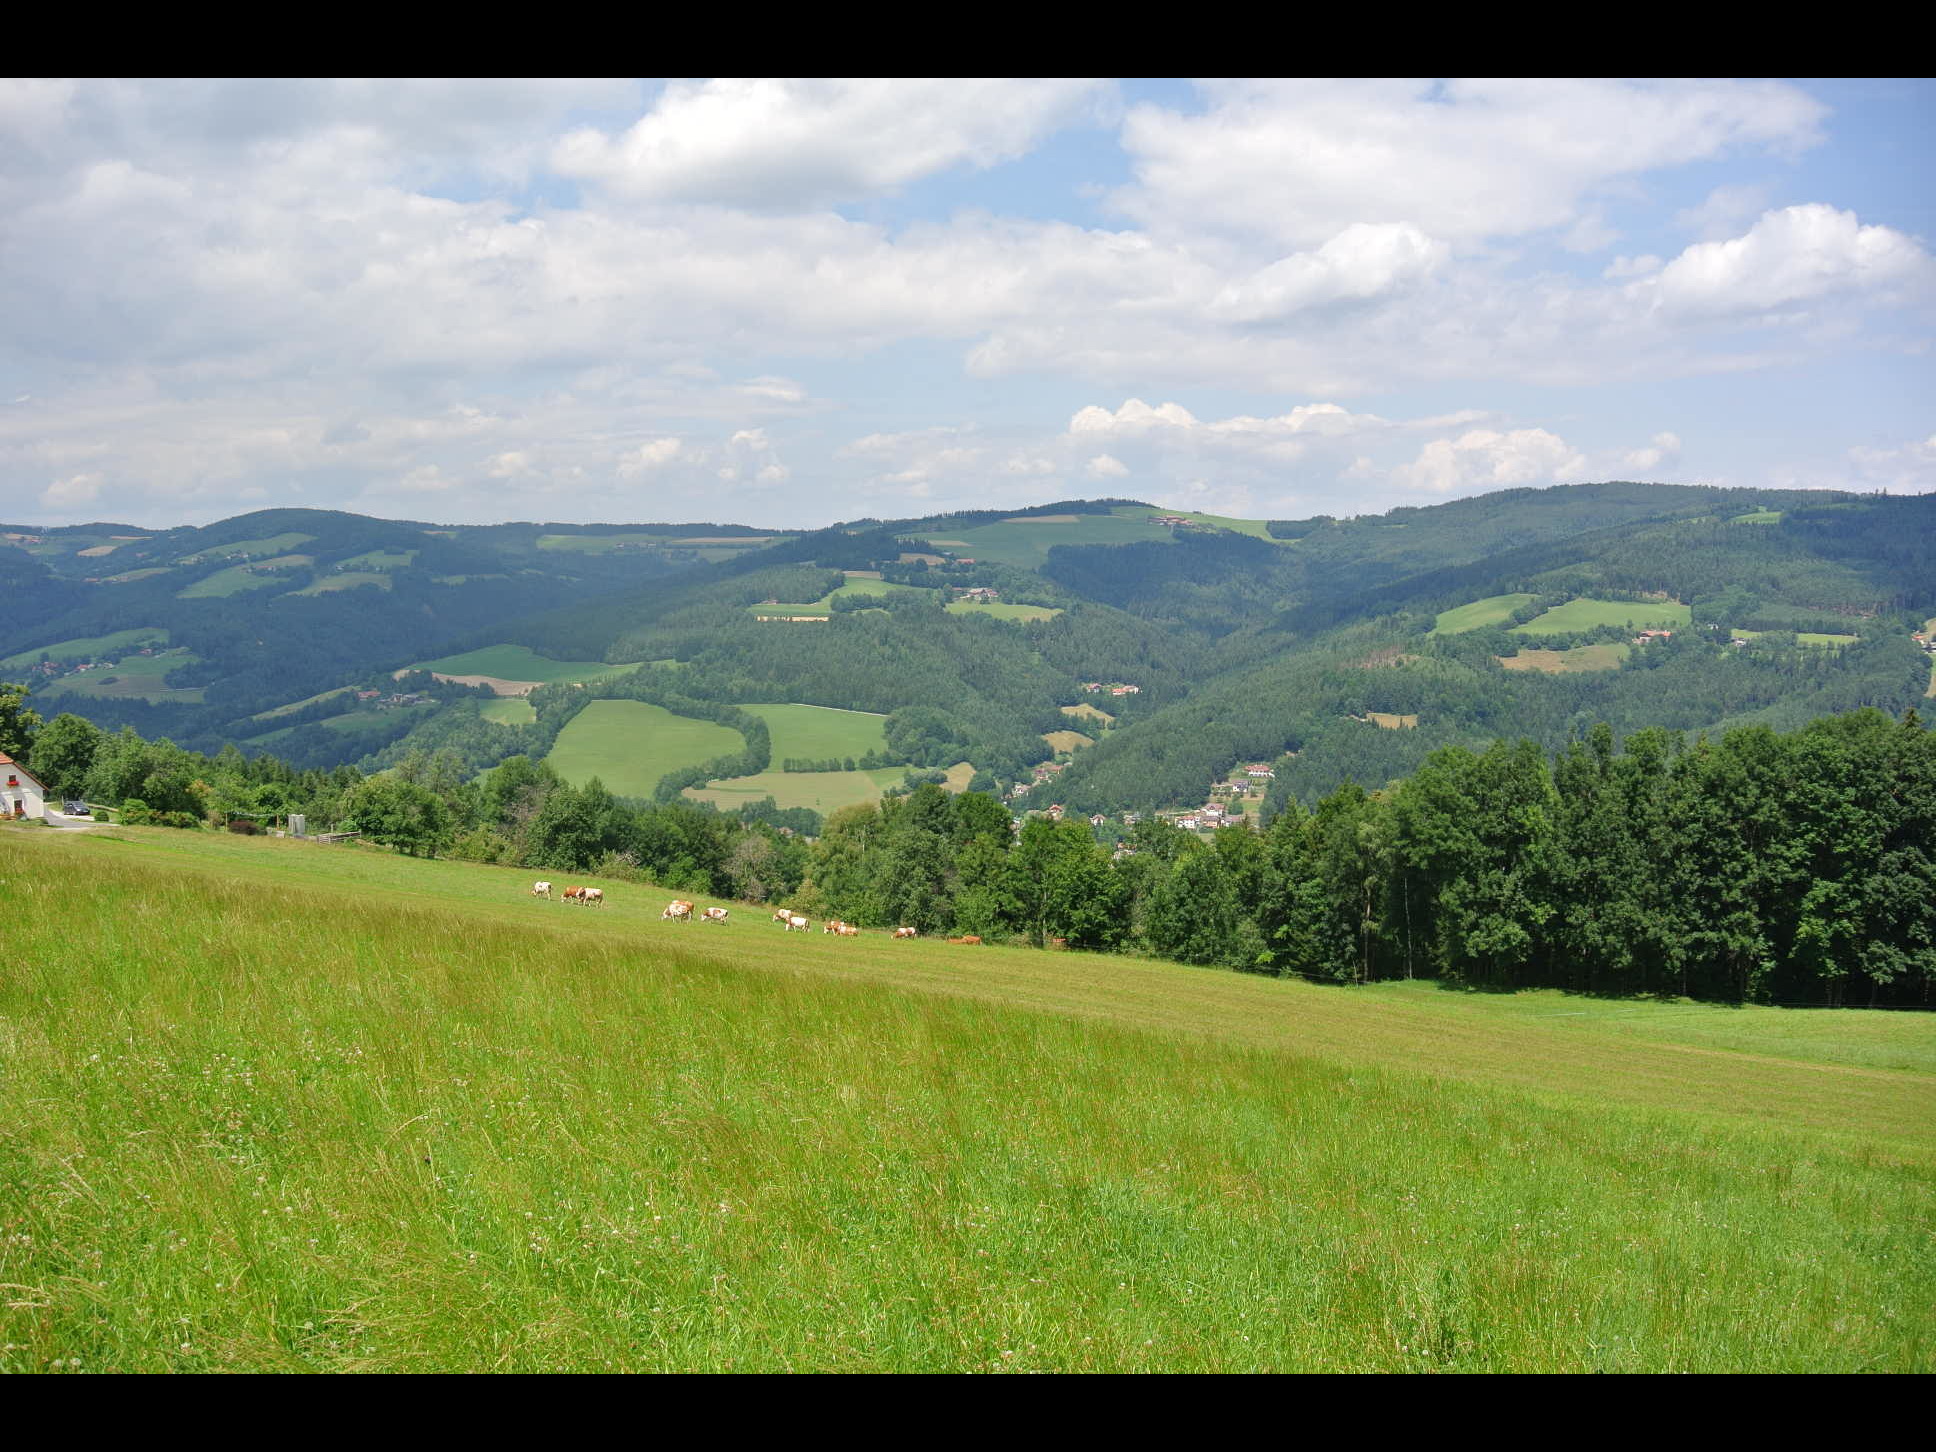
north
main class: Grassland
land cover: Grassland without tree/shrub cover
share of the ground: > 75 %
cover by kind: herbaceous plants 100 %
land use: Agriculture (excluding fallow land and kitchen gardens)
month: July
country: AT
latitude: 47.5880
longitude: 16.0529
